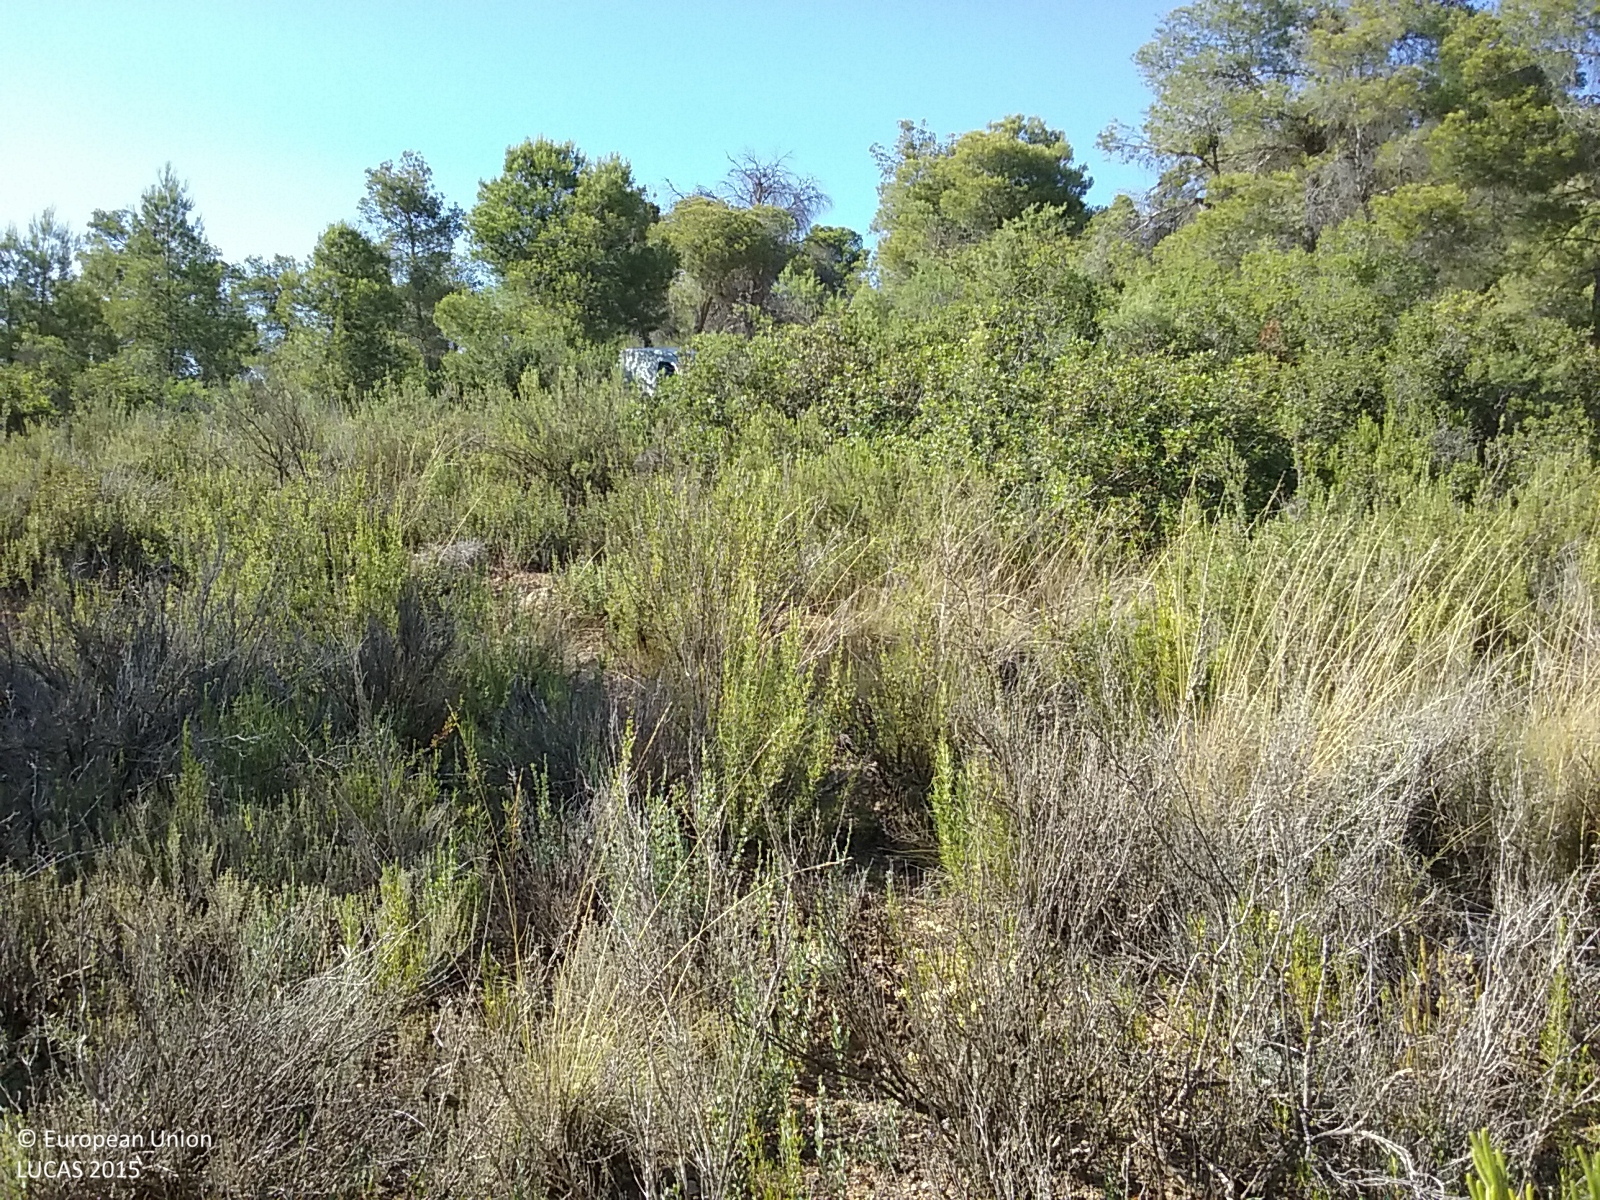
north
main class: Woodland
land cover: Pine dominated coniferous woodland
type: coniferous forest of the mediterranean region
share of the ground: 10 - 25 %
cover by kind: shrubs 65 %, coniferous forest trees 20 %, herbaceous plants 10 %, unconsolidated bare surface 5 %
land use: Semi-natural and natural areas not in use
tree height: > 5 m
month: June
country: ES
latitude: 41.0904
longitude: 0.2402
